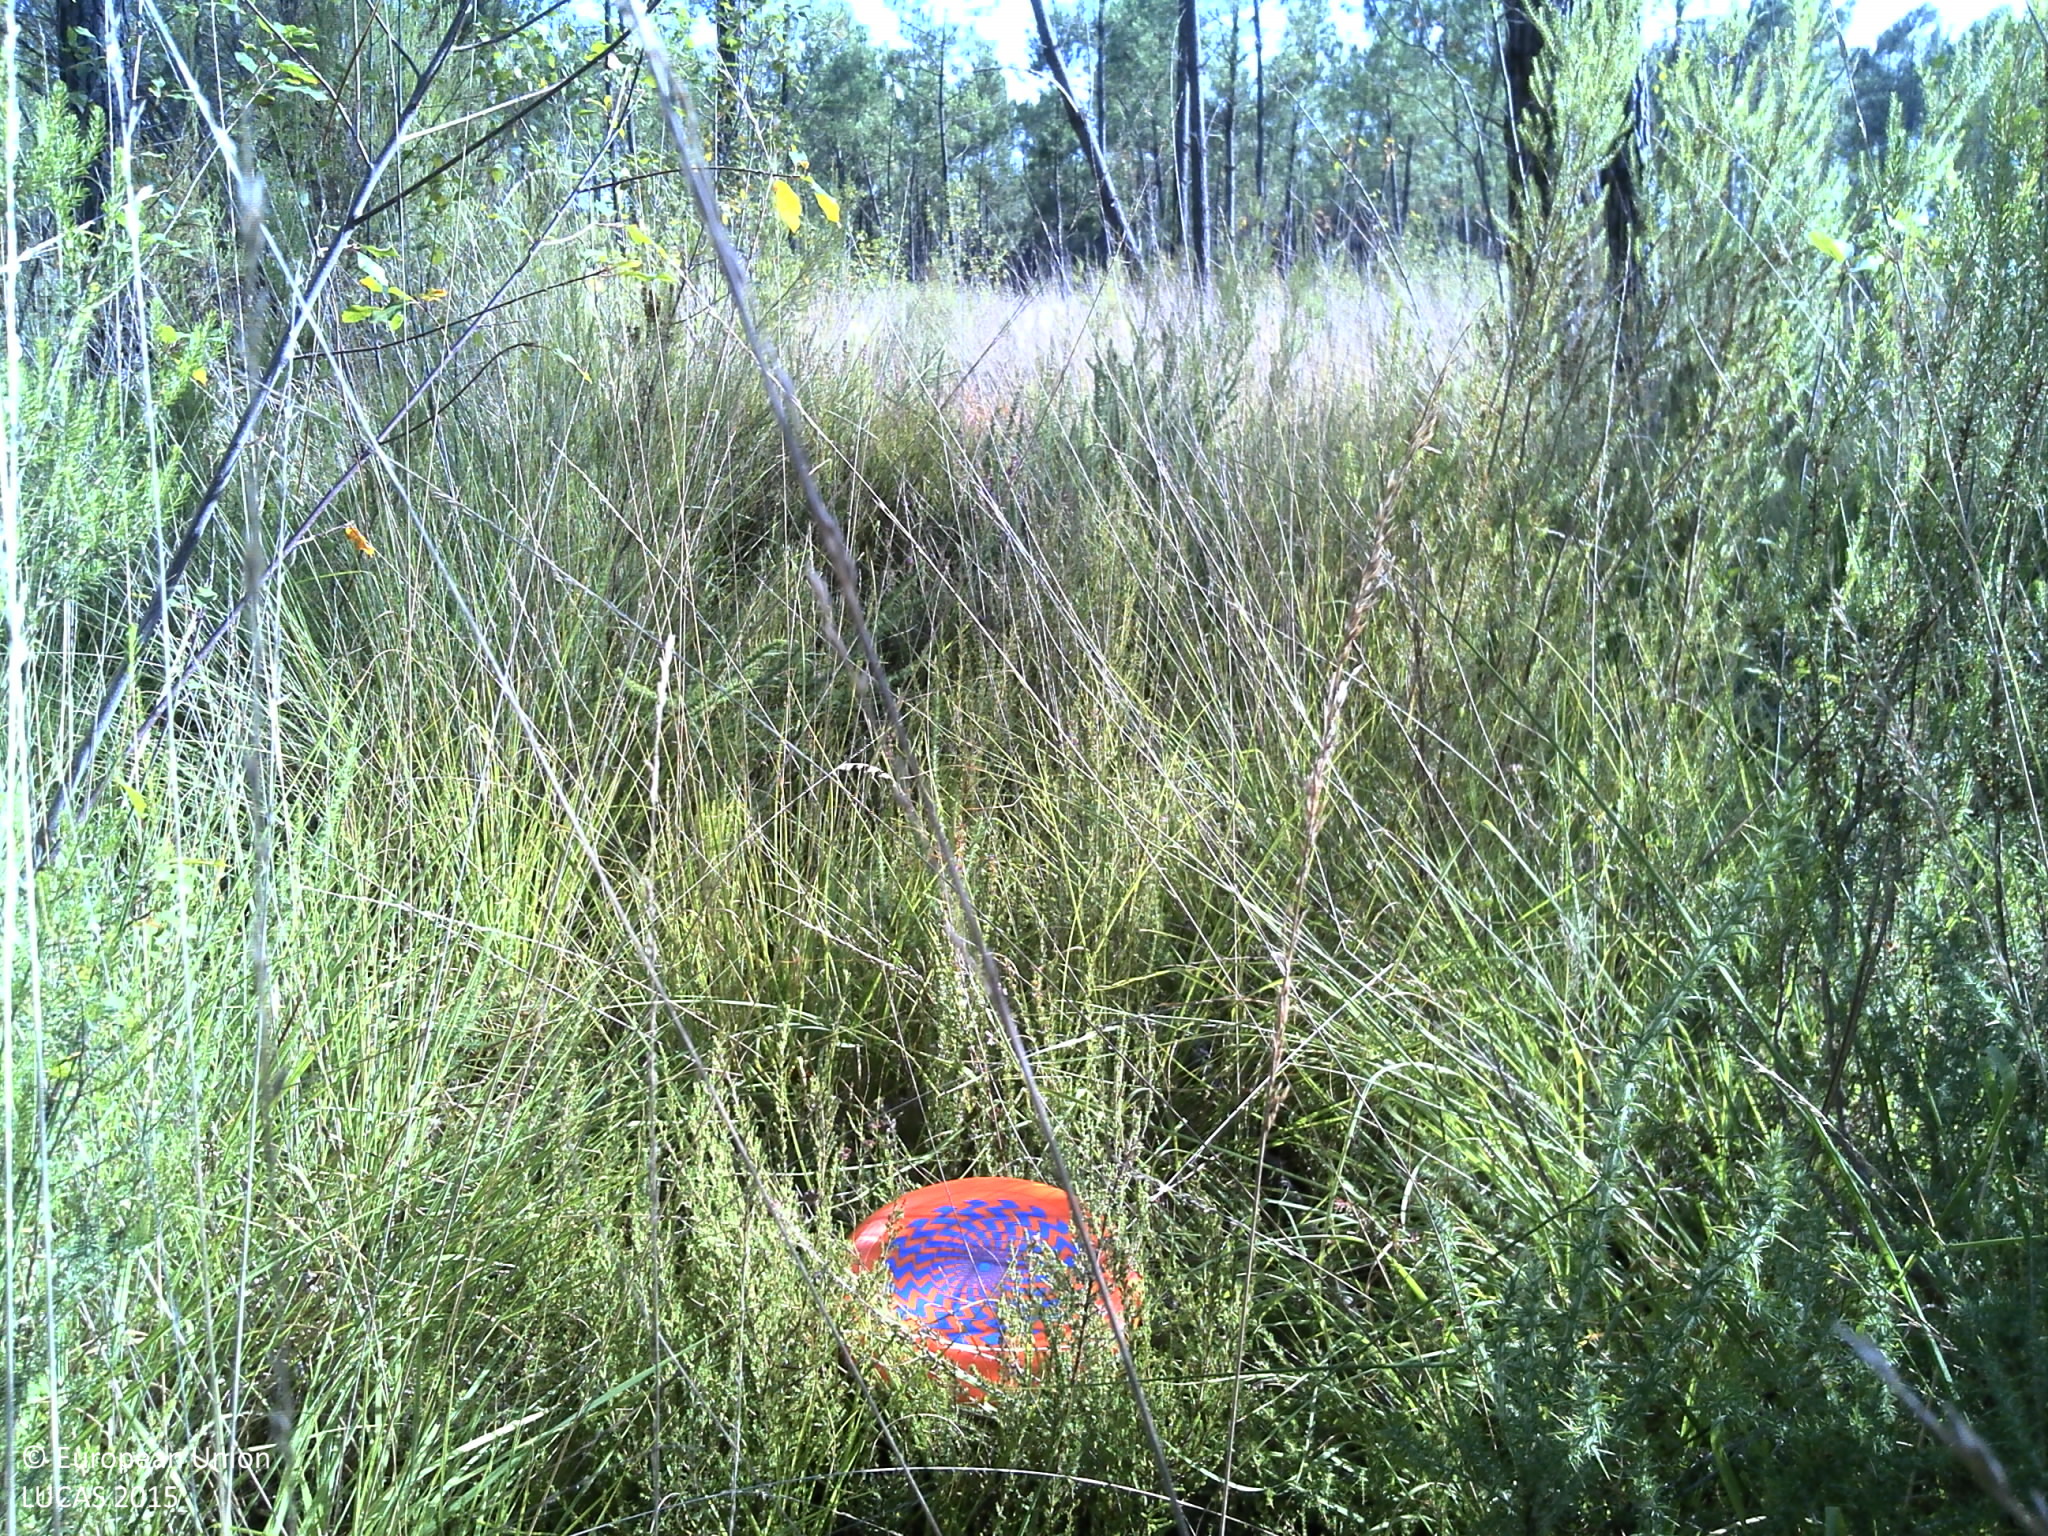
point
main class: Woodland
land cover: Pine dominated coniferous woodland
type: coniferous forest of the mediterranean region
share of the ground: > 75 %
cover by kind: coniferous forest trees 60 %, shrubs 30 %, herbaceous plants 5 %, lichens and mosses 5 %
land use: Forestry
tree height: > 5 m
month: July
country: FR
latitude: 44.5357
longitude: -0.5752
